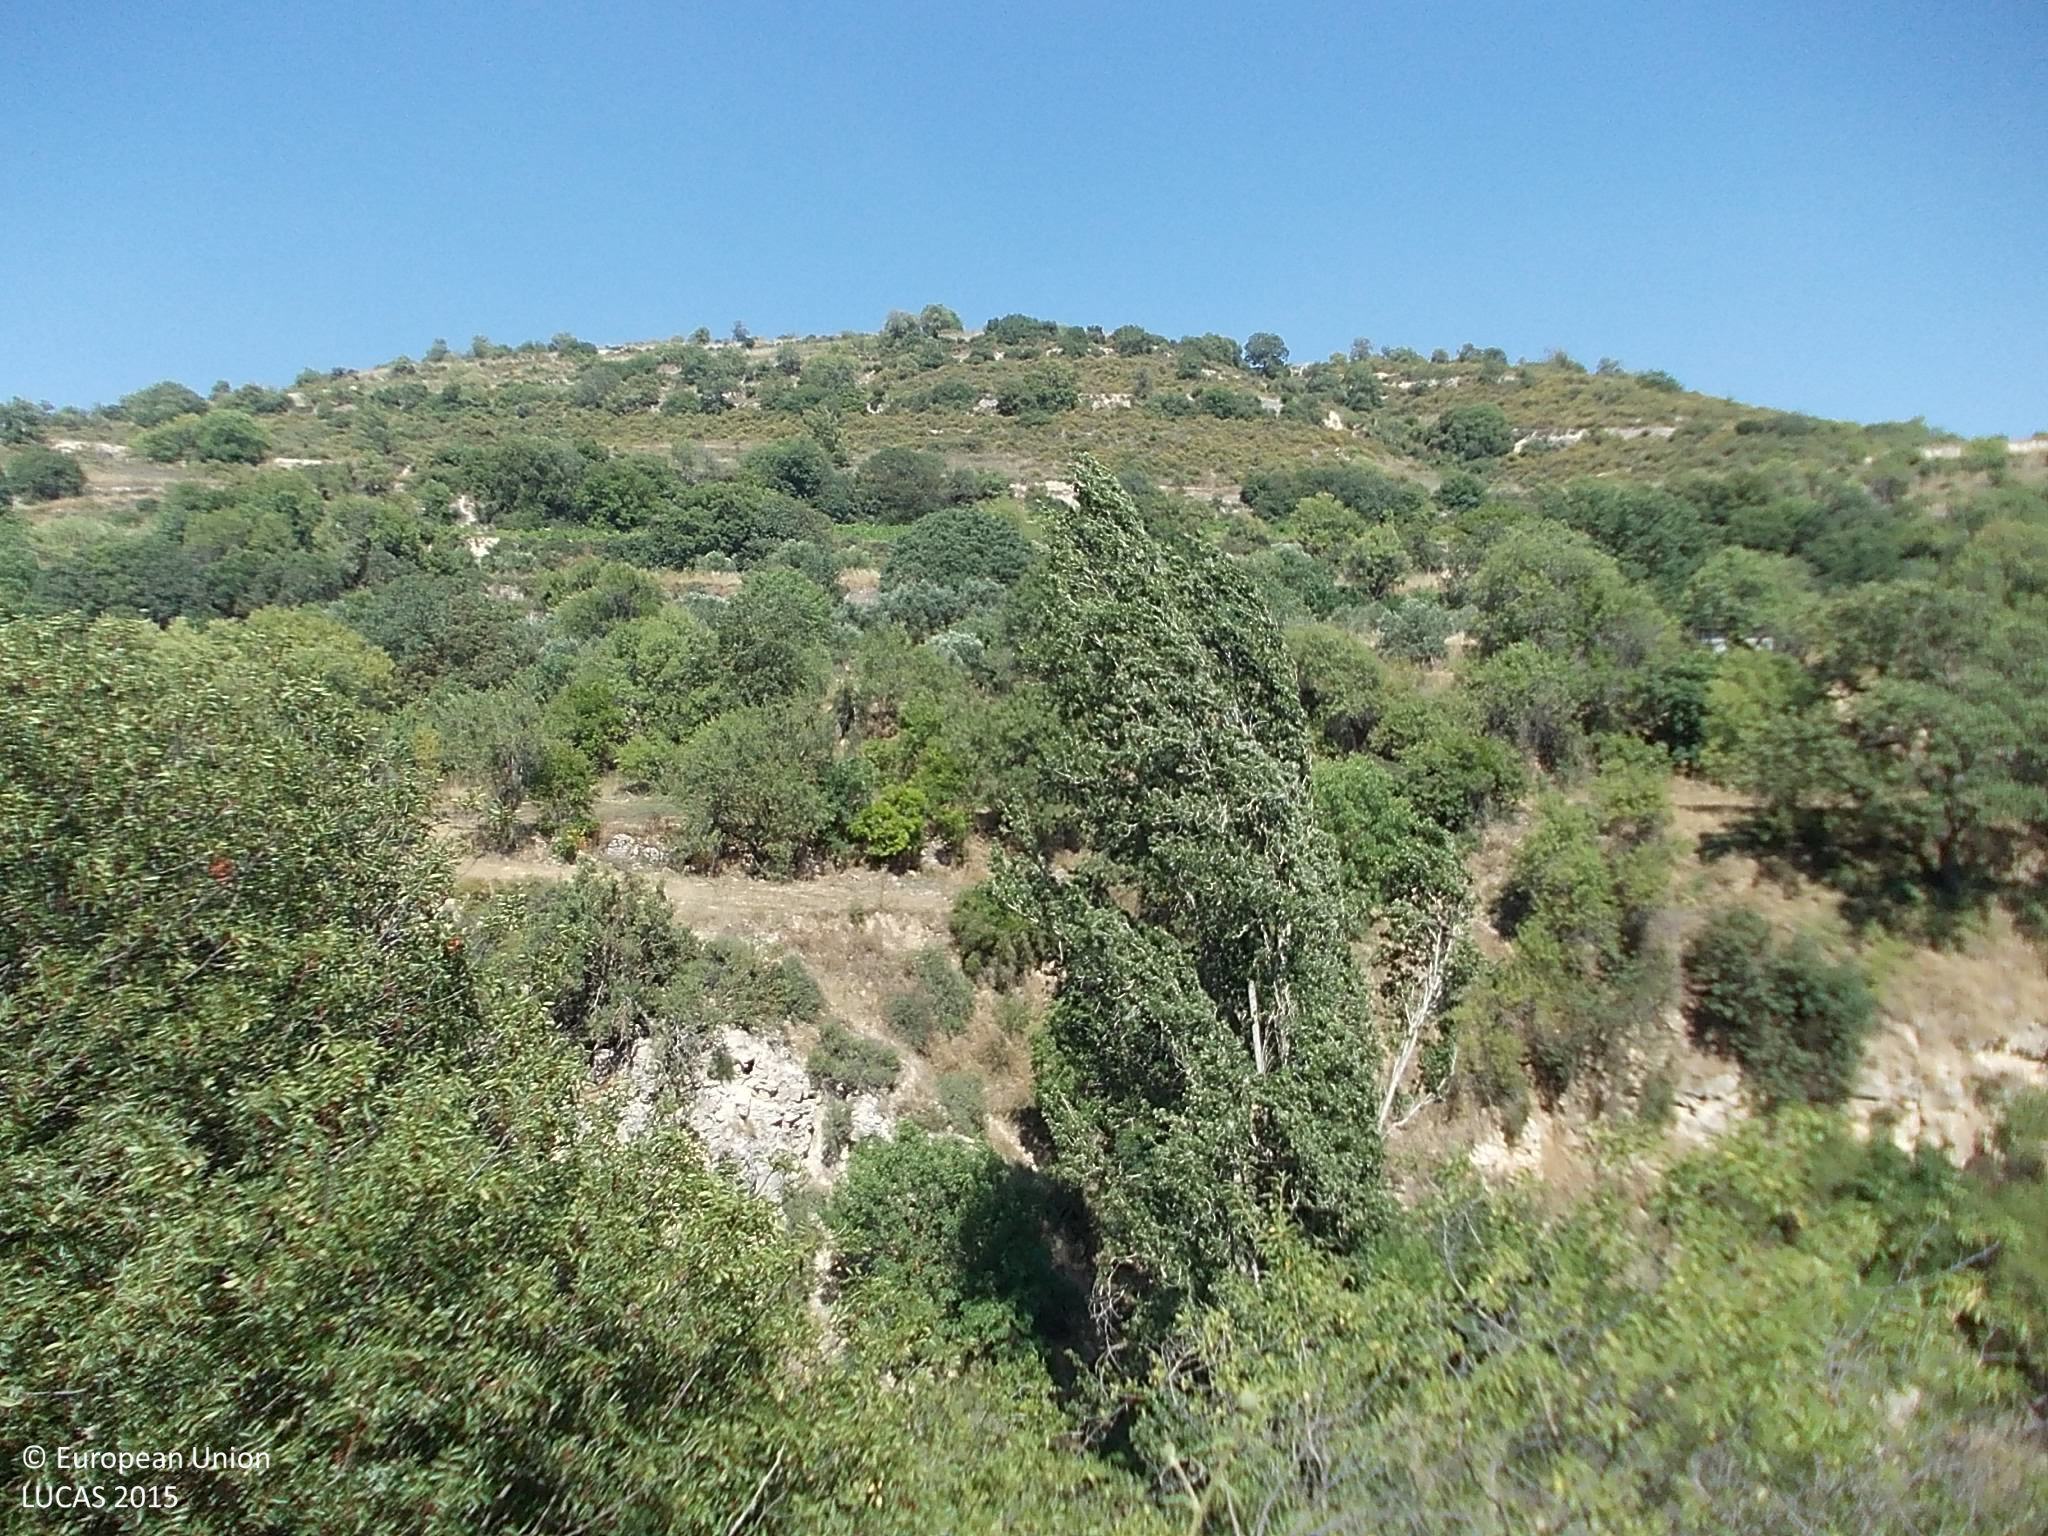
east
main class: Woodland
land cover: Broadleaved woodland
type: broadleaved evergreen forest
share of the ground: > 75 %
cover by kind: broadleaved forest trees 75 %, shrubs 25 %
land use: Semi-natural and natural areas not in use
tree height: > 5 m
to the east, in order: Broadleaved woodland; Inland fresh running water; Broadleaved woodland; Grassland without tree/shrub cover; Broadleaved woodland; Grassland without tree/shrub cover; Olive groves; Broadleaved woodland; Vineyards; Broadleaved woodland; Paved roads, cycling and walking lanes; Shrubland with sparse tree cover
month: July
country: CY
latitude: 34.8358
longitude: 32.7618
